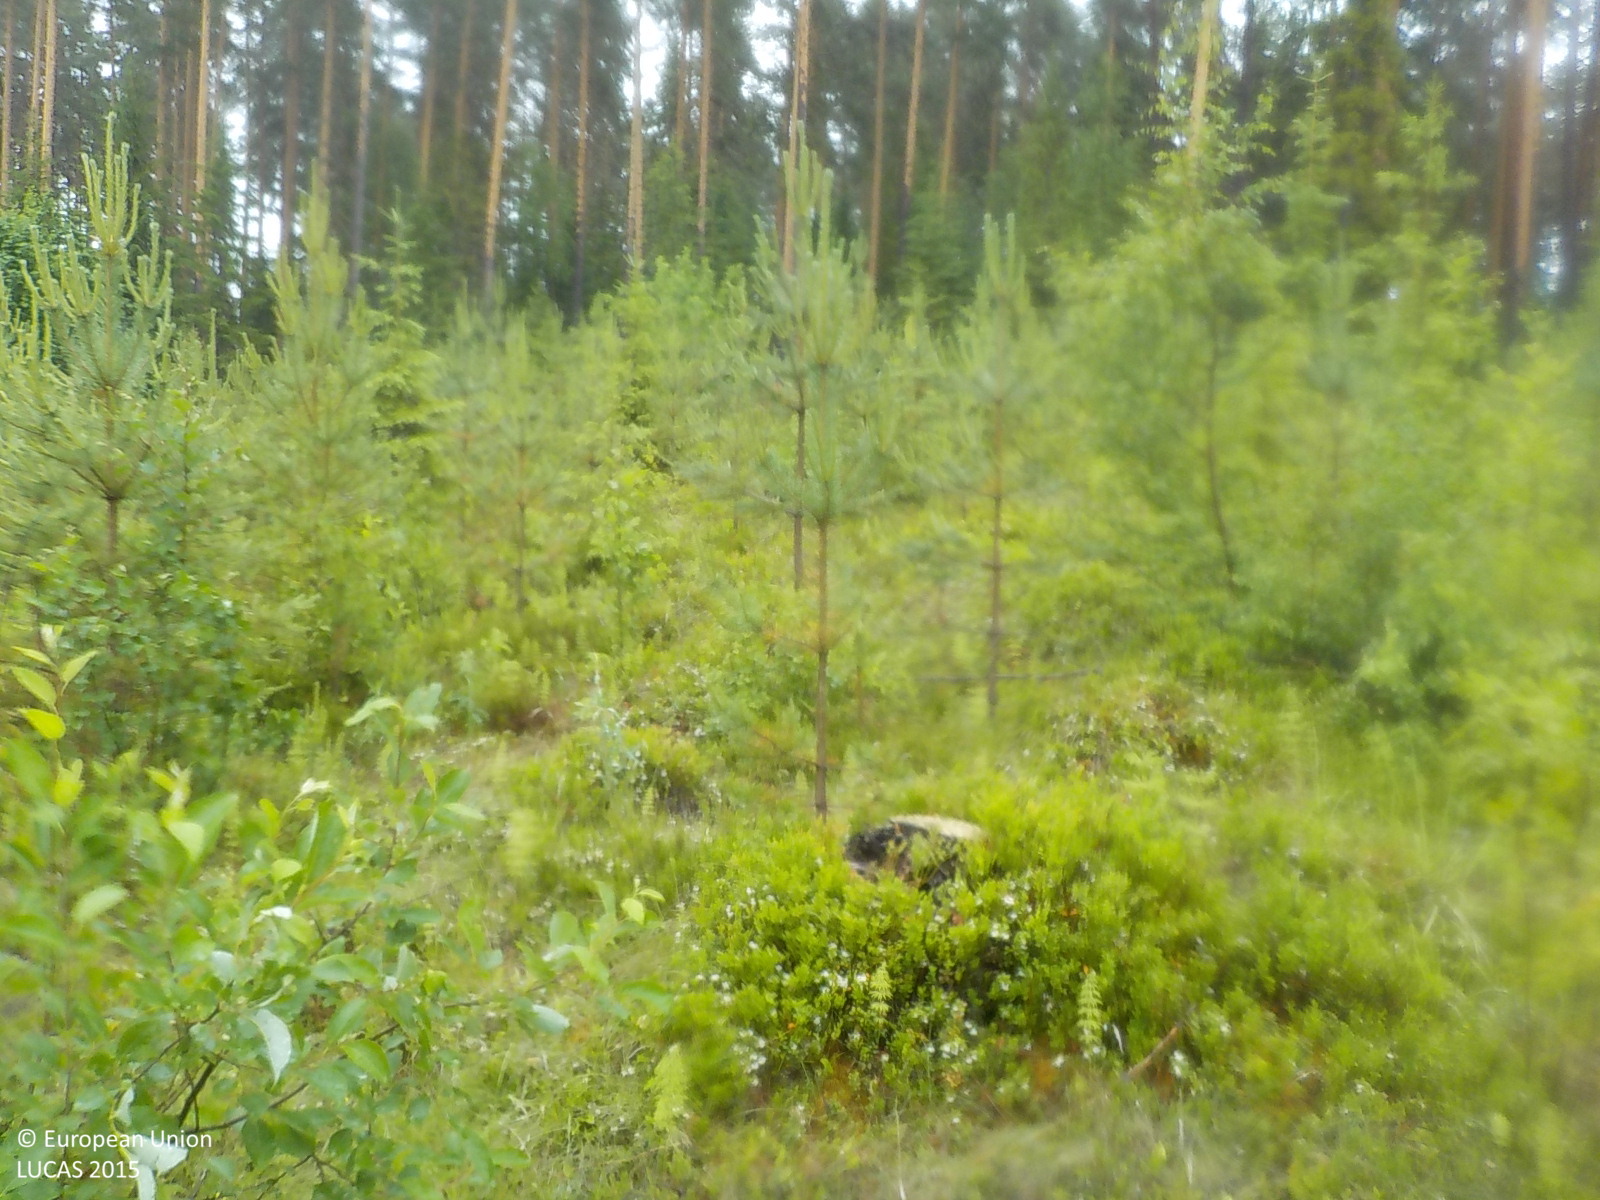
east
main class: Woodland
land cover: Pine dominated mixed woodland
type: boreal forest
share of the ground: > 75 %
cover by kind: coniferous forest trees 50 %, broadleaved forest trees 25 %, shrubs 25 %
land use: Forestry
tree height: < 5 m
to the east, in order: Pine dominated mixed woodland; Shrubland without tree cover; Pine dominated coniferous woodland; Paved roads, cycling and walking lanes; Broadleaved woodland; Pine dominated mixed woodland; Electric lines; Pine dominated mixed woodland
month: July
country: SE
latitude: 63.1371
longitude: 17.0179
